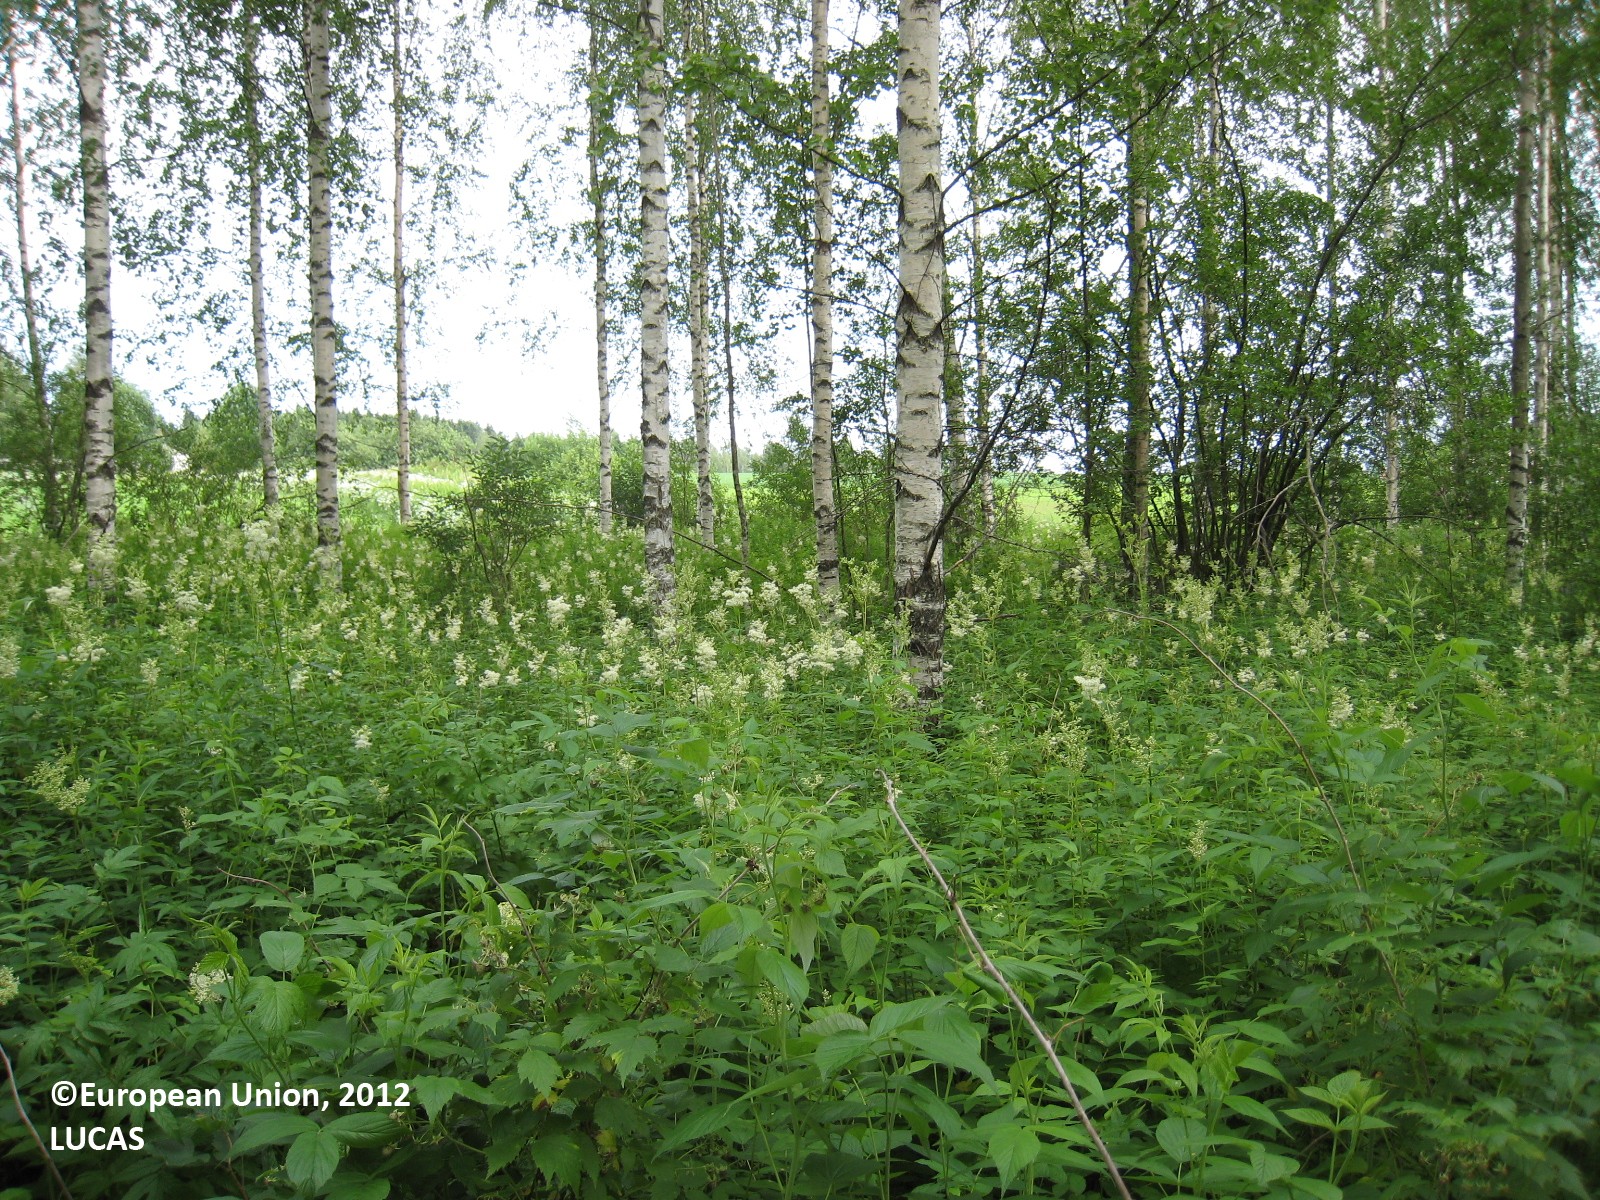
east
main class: Woodland
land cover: Broadleaved woodland
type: non-riverine alder, birch or aspen forest
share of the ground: 50 - 75 %
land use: Forestry
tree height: > 5 m
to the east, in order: Broadleaved woodland; Ditches and canals; Abandoned hedges; Dry stone walls; Tracks; Grassland with sparse tree/shrub cover; Temporary grasslands; Oats; Shruby margins; Ditches and canals; Spruce dominated mixed woodland
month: July
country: FI
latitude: 61.8329
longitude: 27.0420
